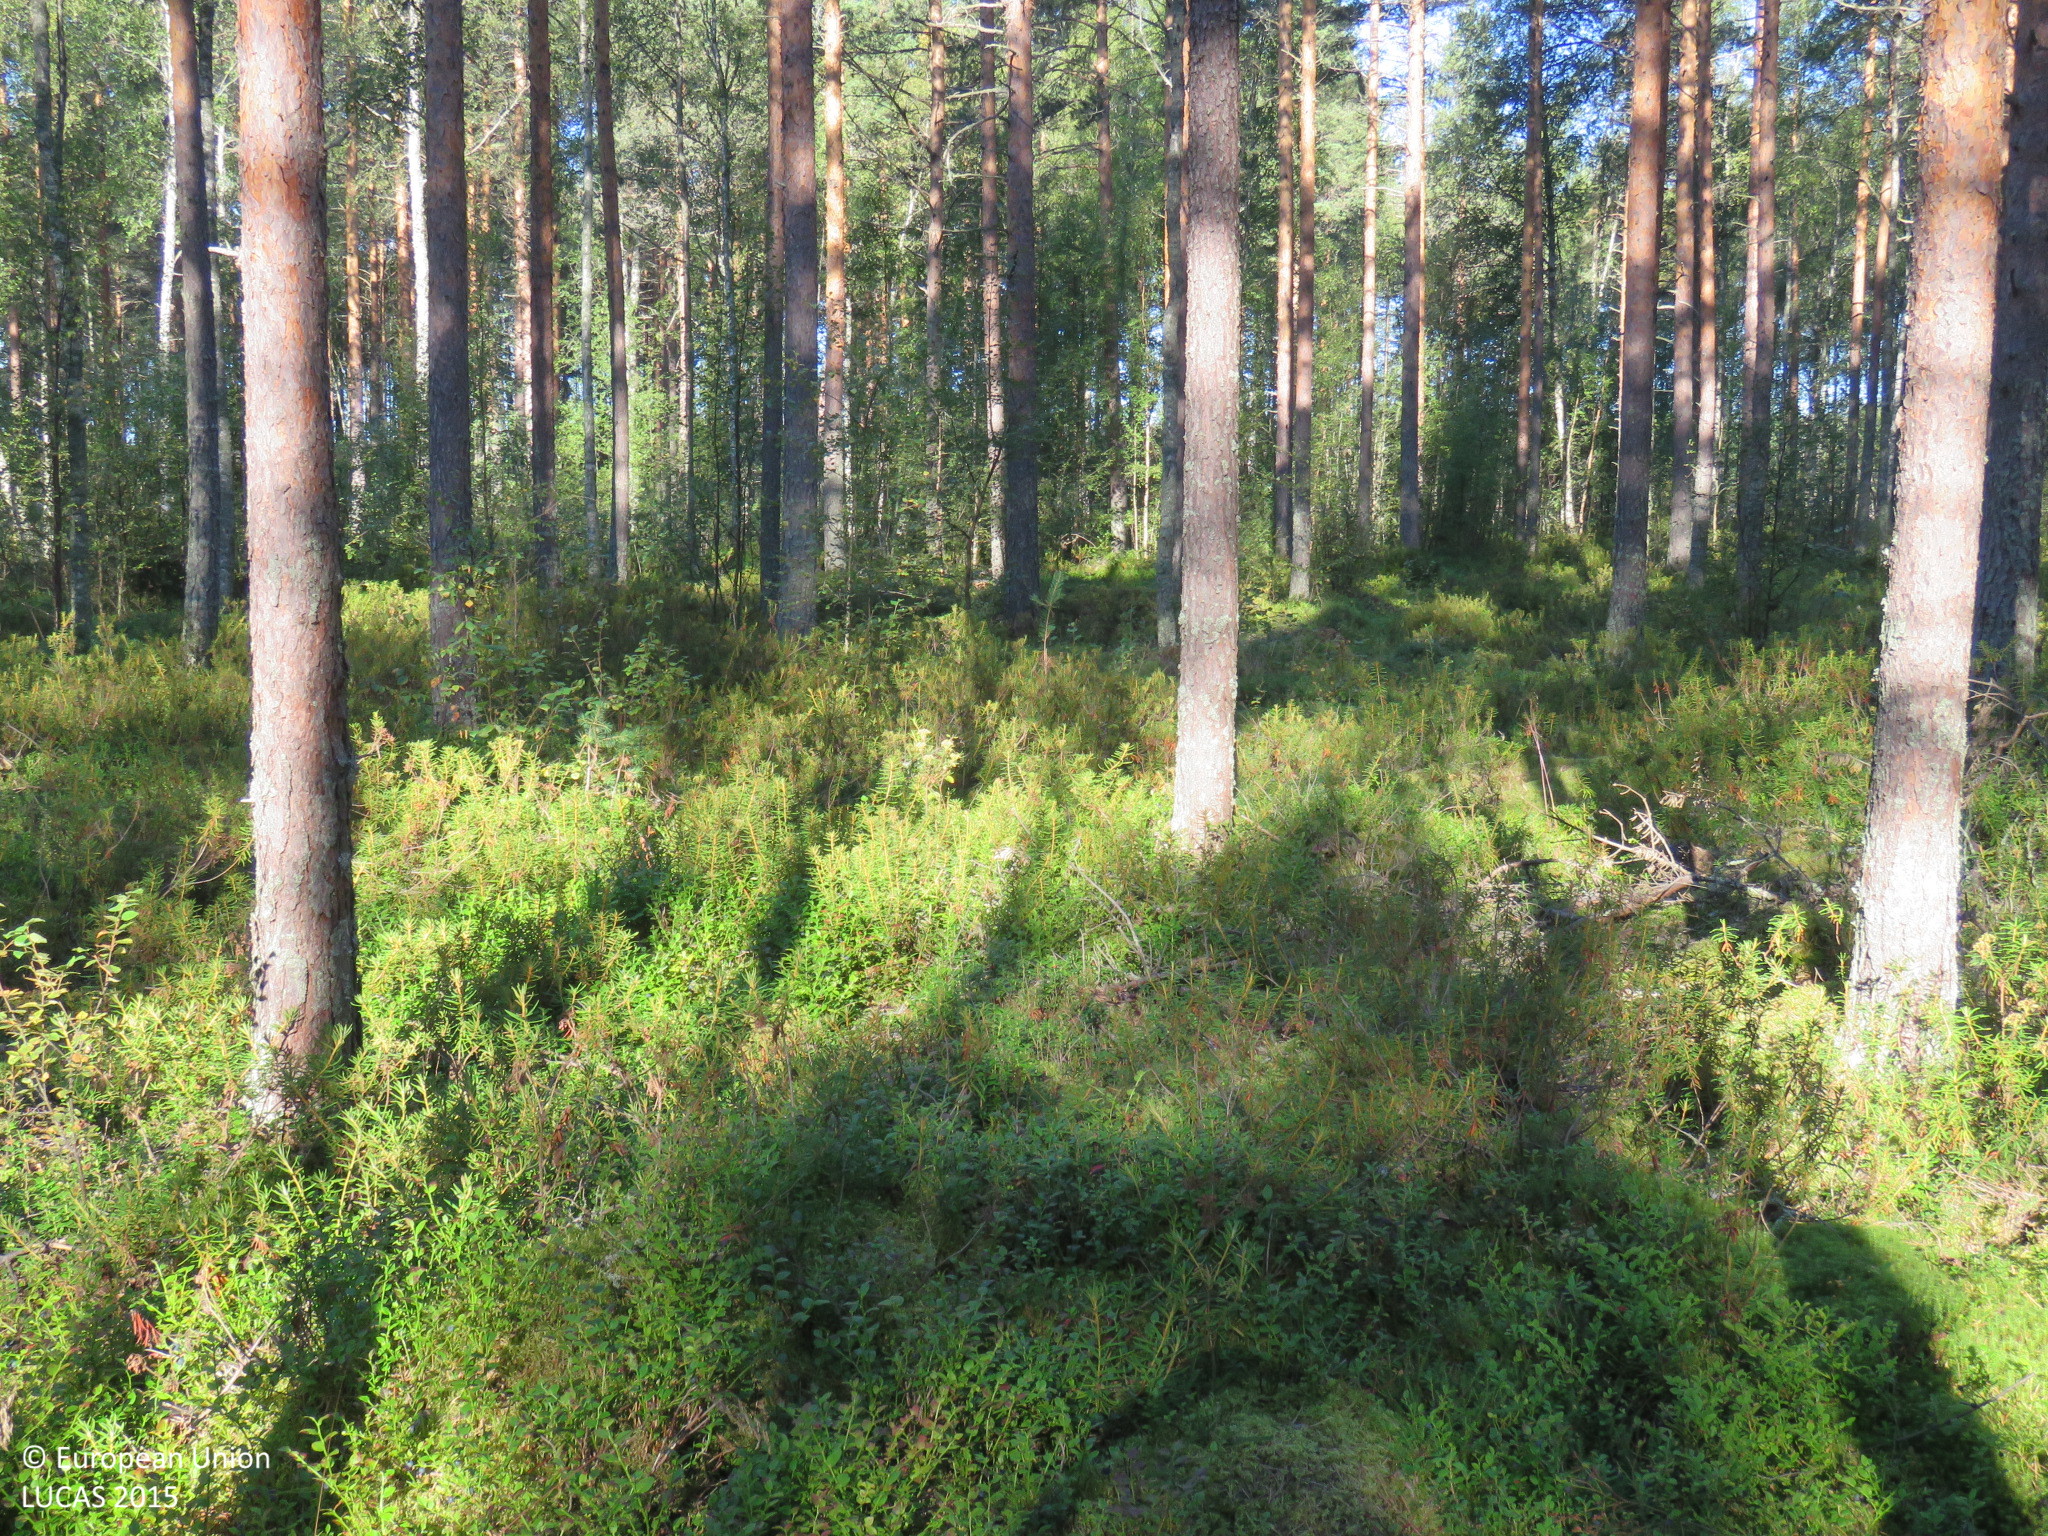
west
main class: Woodland
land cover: Pine dominated coniferous woodland
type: boreal forest
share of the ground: > 75 %
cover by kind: coniferous forest trees 60 %, shrubs 20 %, broadleaved forest trees 15 %, lichens and mosses 5 %
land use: Forestry
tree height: > 5 m
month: August
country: FI
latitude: 64.9842
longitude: 24.6695
